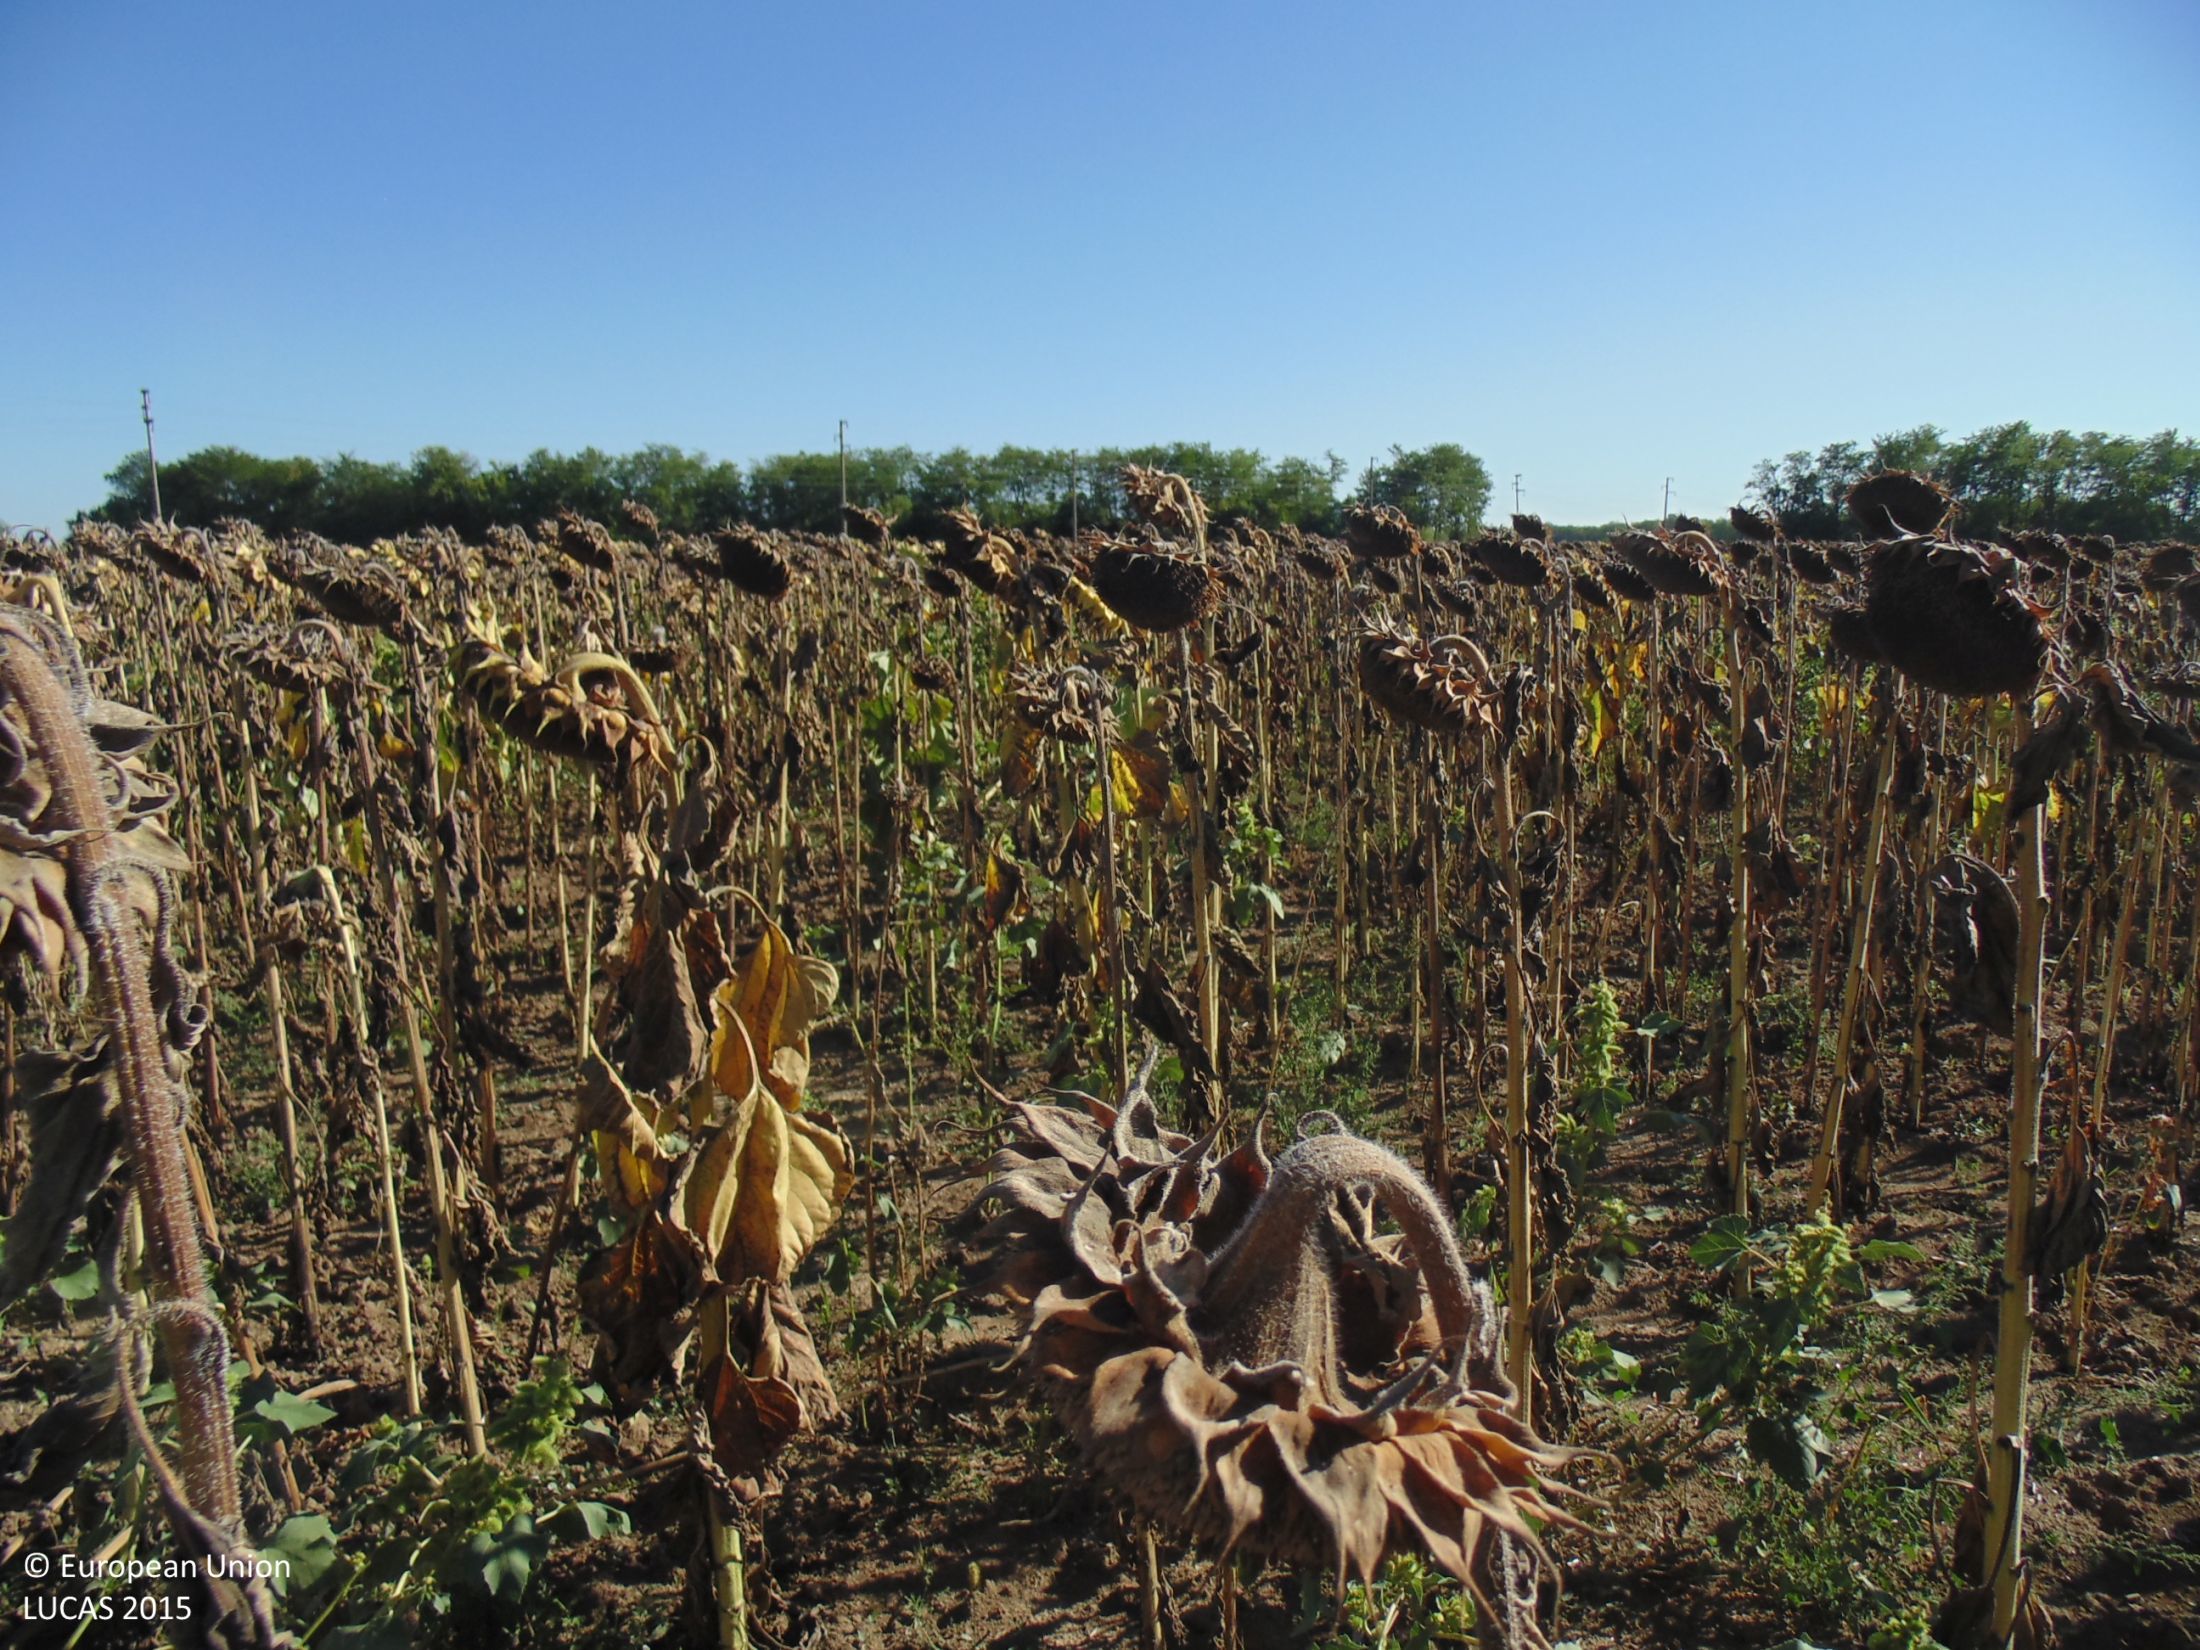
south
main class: Cropland
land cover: Sunflower
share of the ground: > 75 %
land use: Agriculture (excluding fallow land and kitchen gardens)
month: September
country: BG
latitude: 43.8570
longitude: 27.2088
